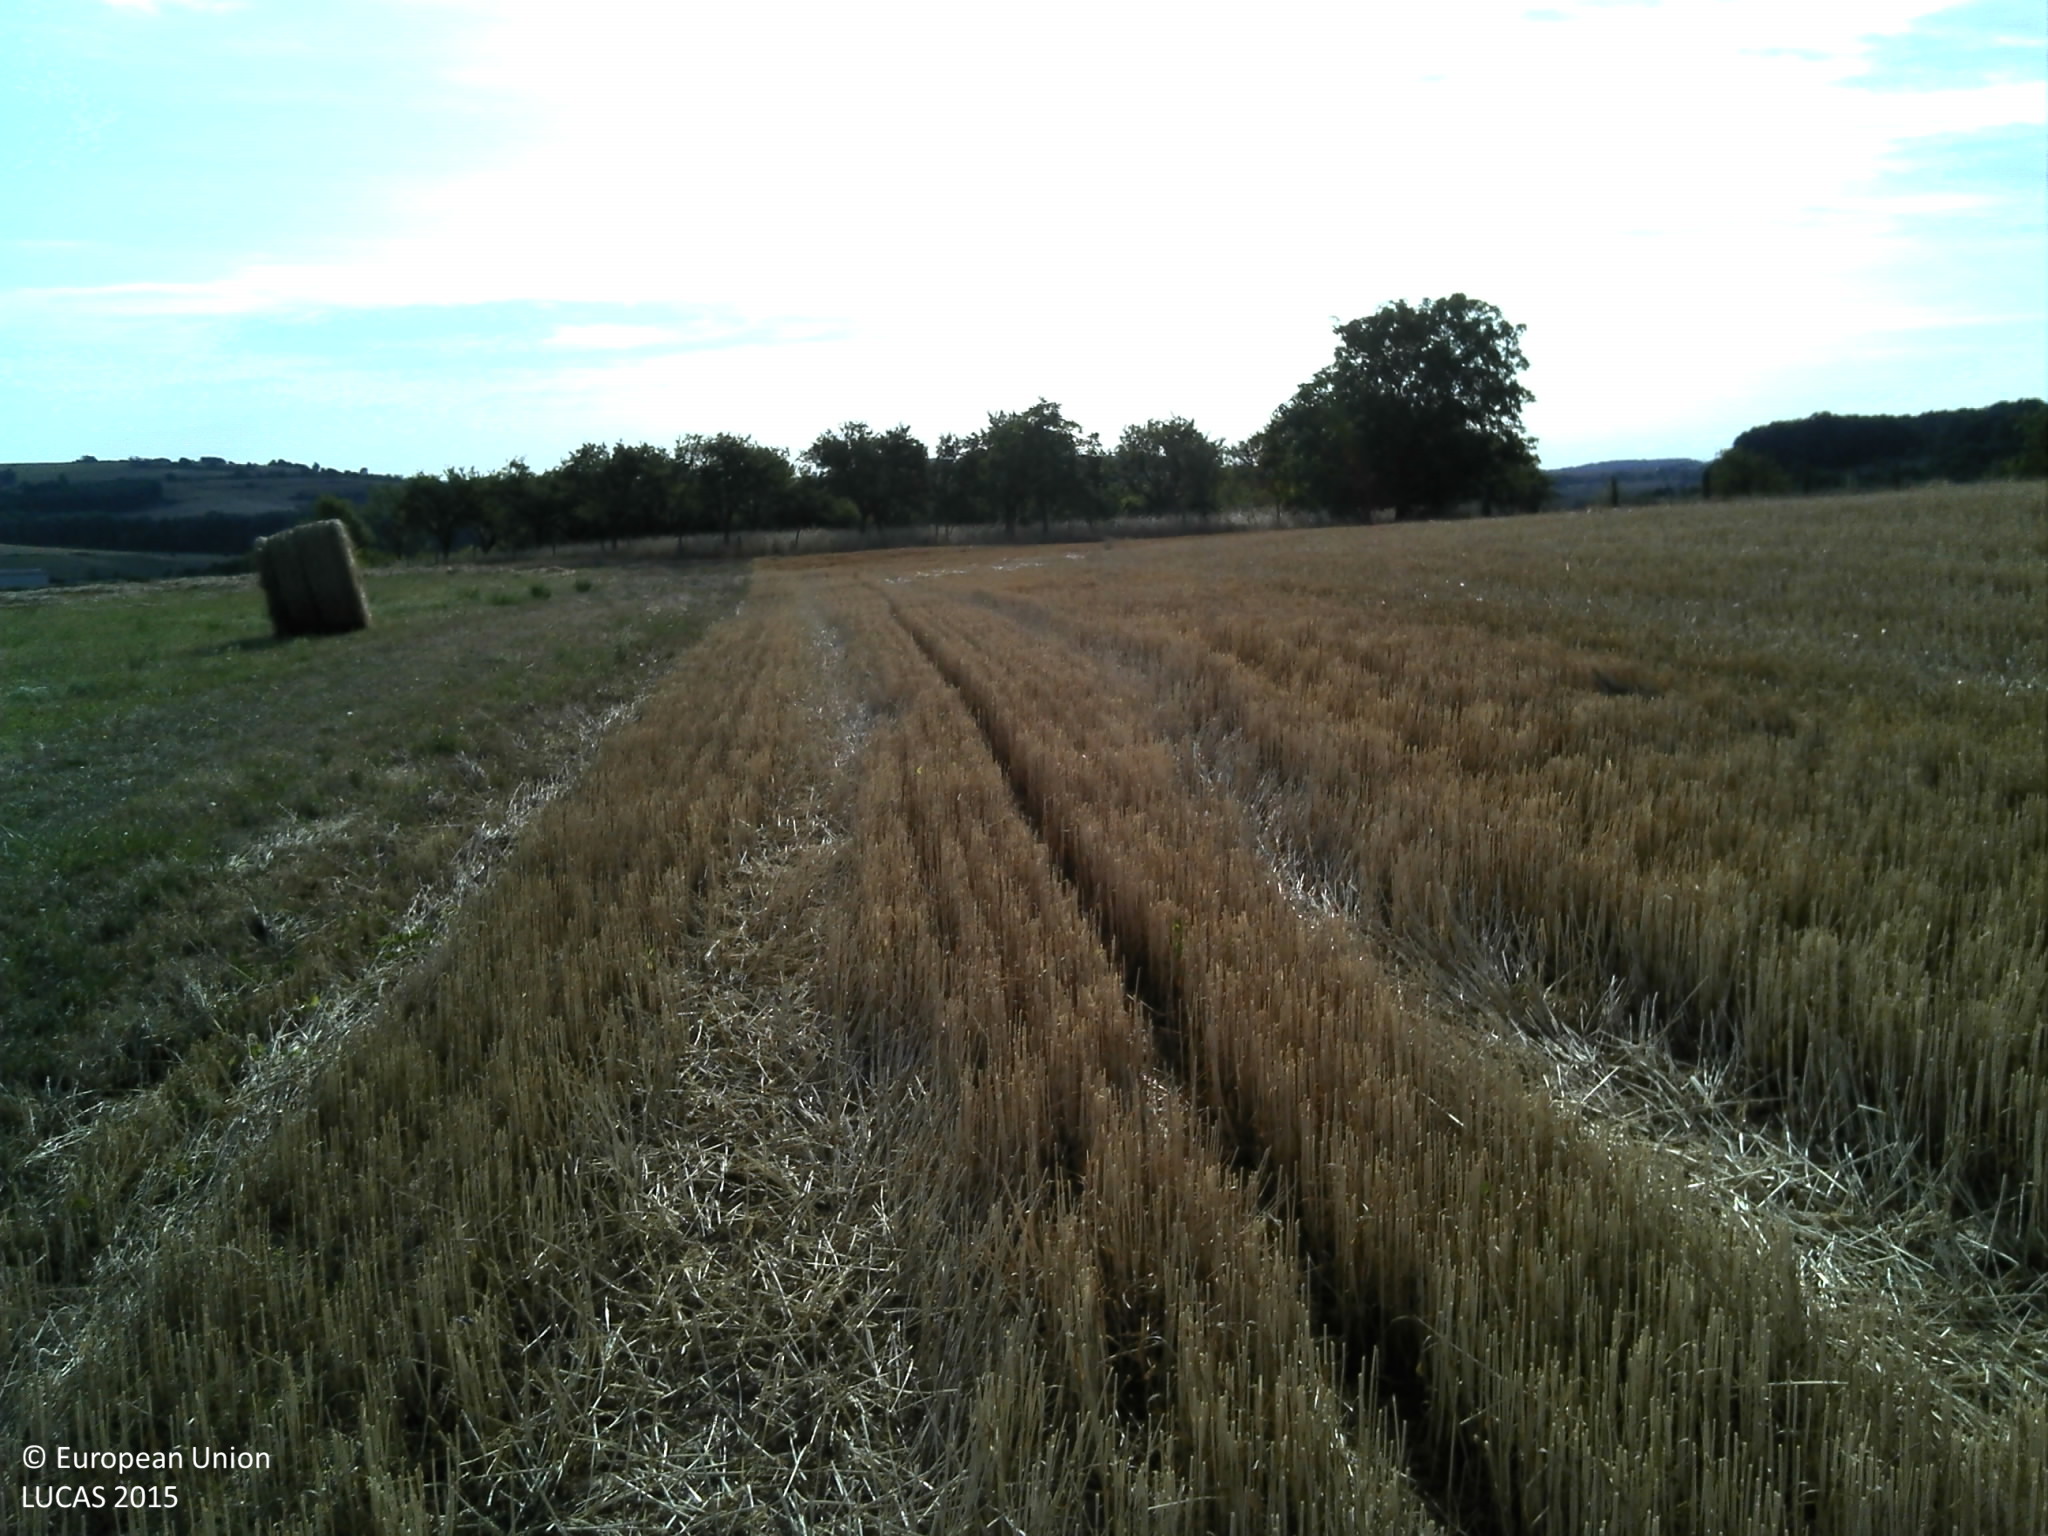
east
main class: Cropland
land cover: Common wheat
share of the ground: < 10 %
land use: Agriculture (excluding fallow land and kitchen gardens)
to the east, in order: Common wheat; Grassland without tree/shrub cover; Other fruit trees and berries; Shrubland with sparse tree cover; Fences; Grassland without tree/shrub cover
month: July
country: FR
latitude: 48.3565
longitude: 6.2081
